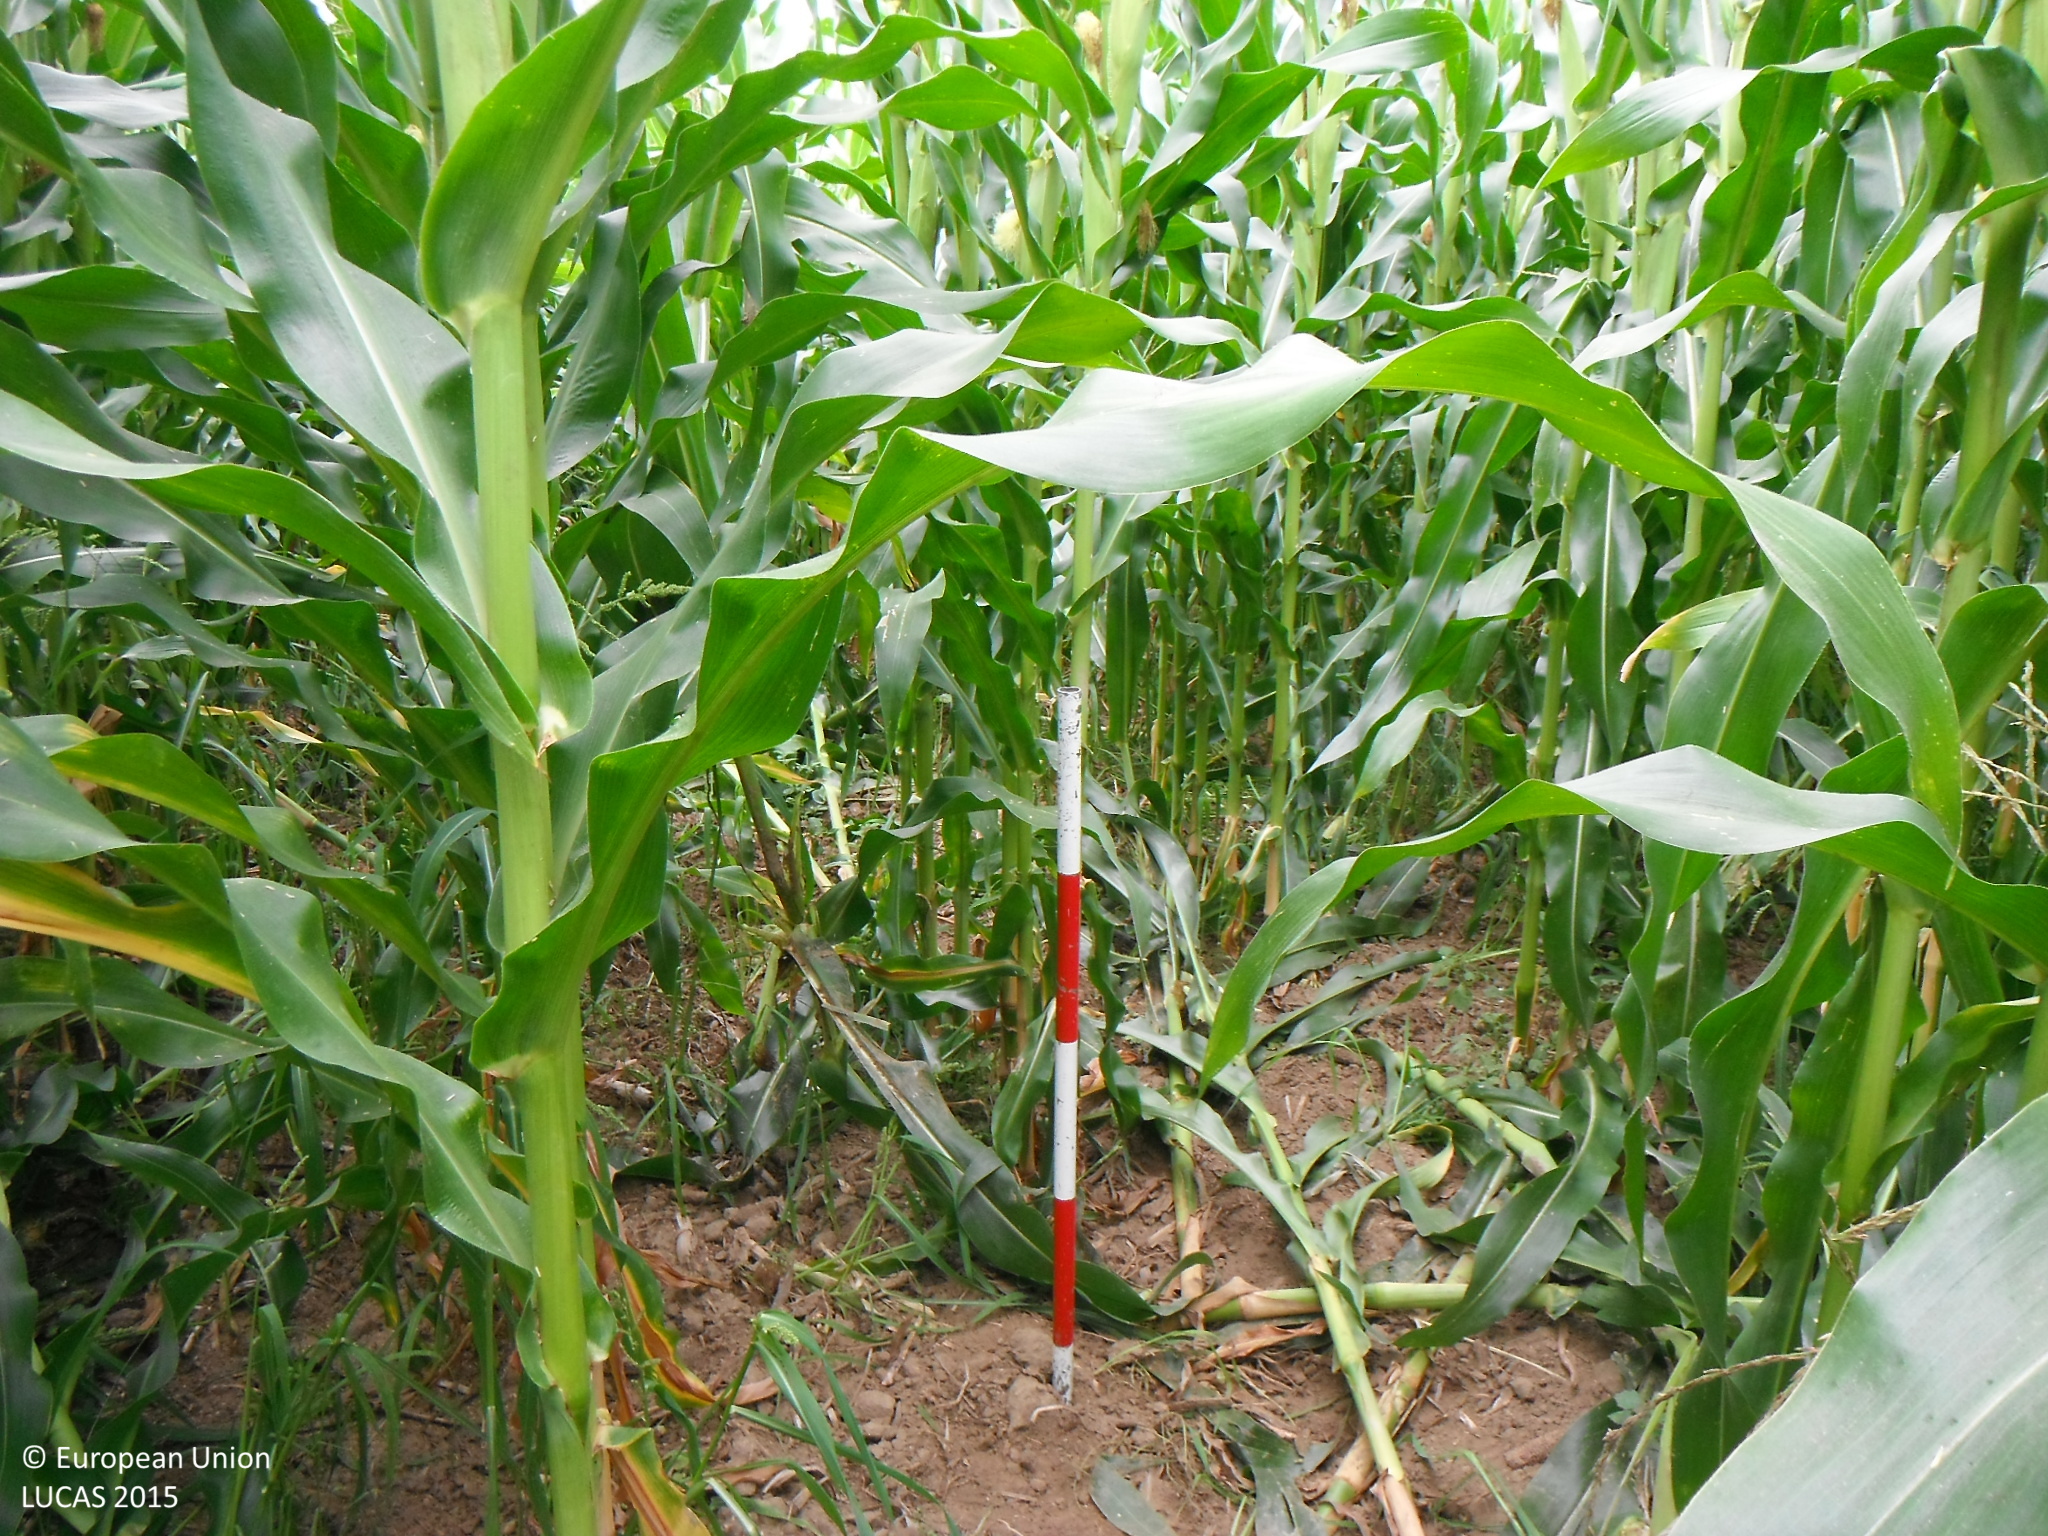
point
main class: Cropland
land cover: Maize
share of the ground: > 75 %
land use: Agriculture (excluding fallow land and kitchen gardens)
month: July
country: SK
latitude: 48.1698
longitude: 19.9653
